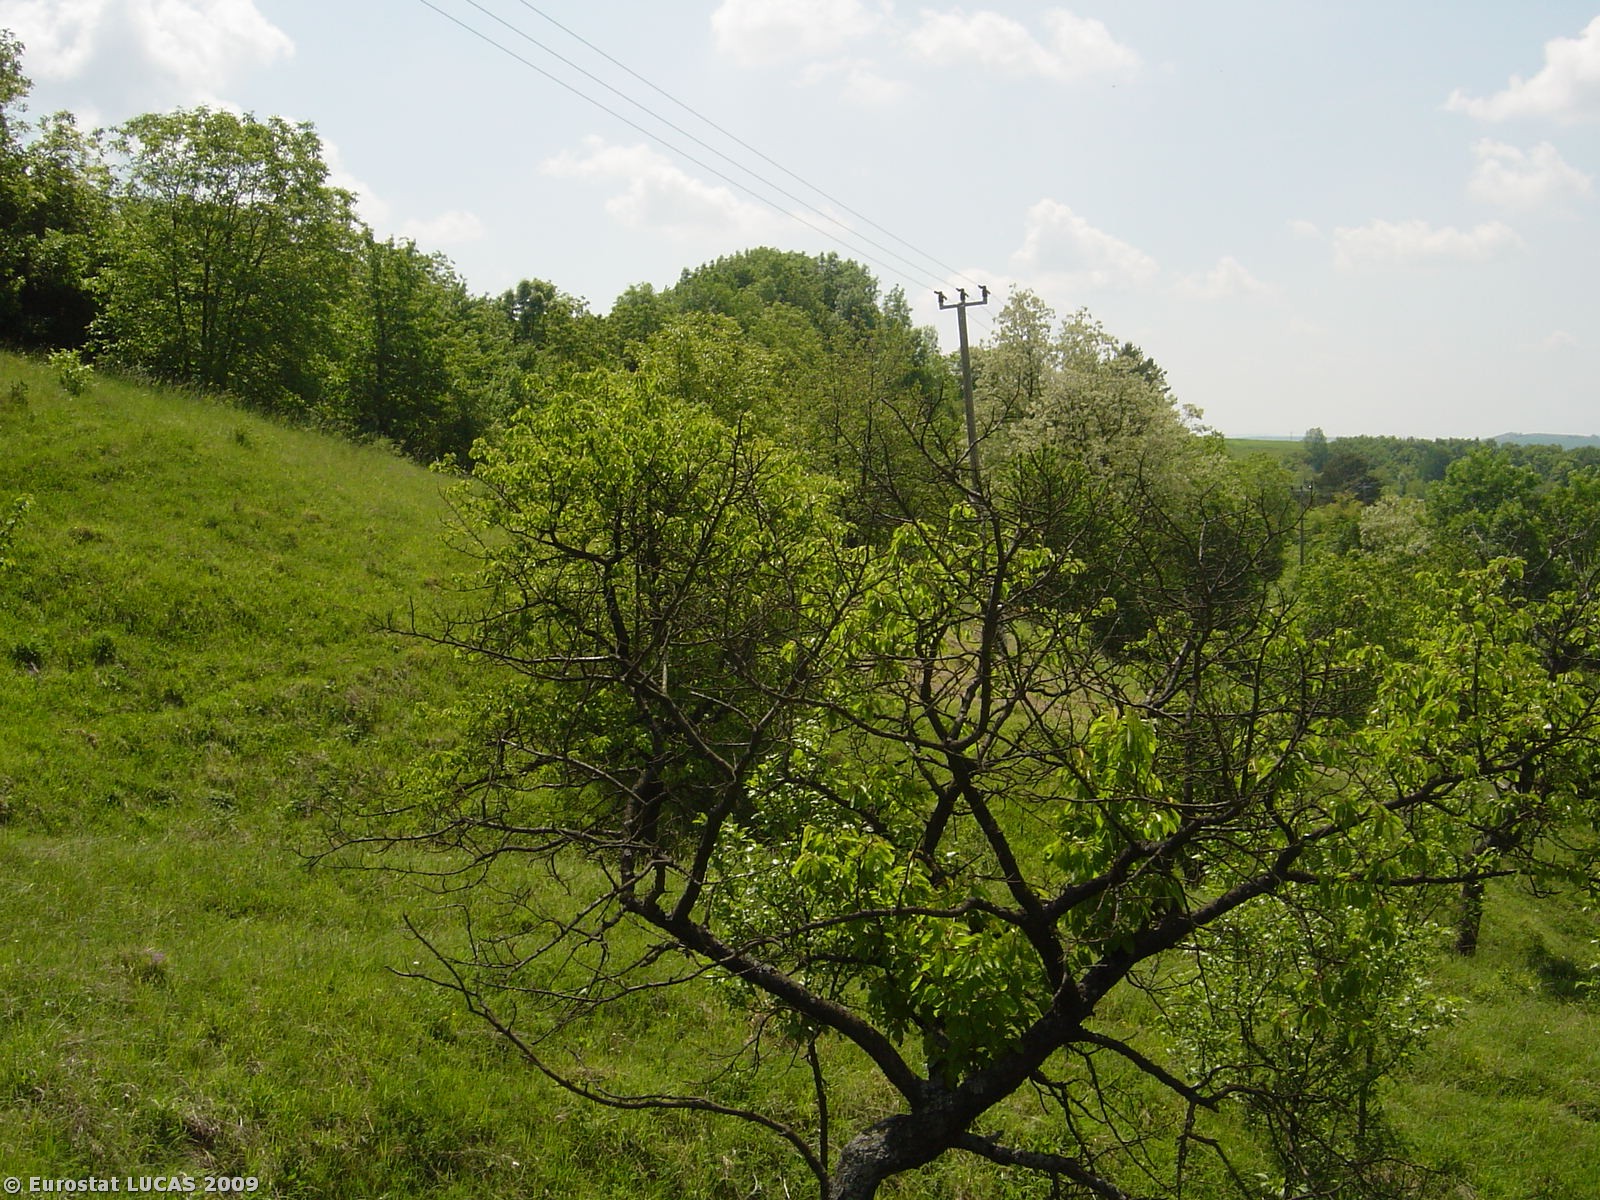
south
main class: Grassland
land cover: Grassland with sparse tree/shrub cover
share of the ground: > 75 %
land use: Agriculture (excluding fallow land and kitchen gardens)
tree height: > 5 m
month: May
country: CZ
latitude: 49.0628
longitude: 17.0576
